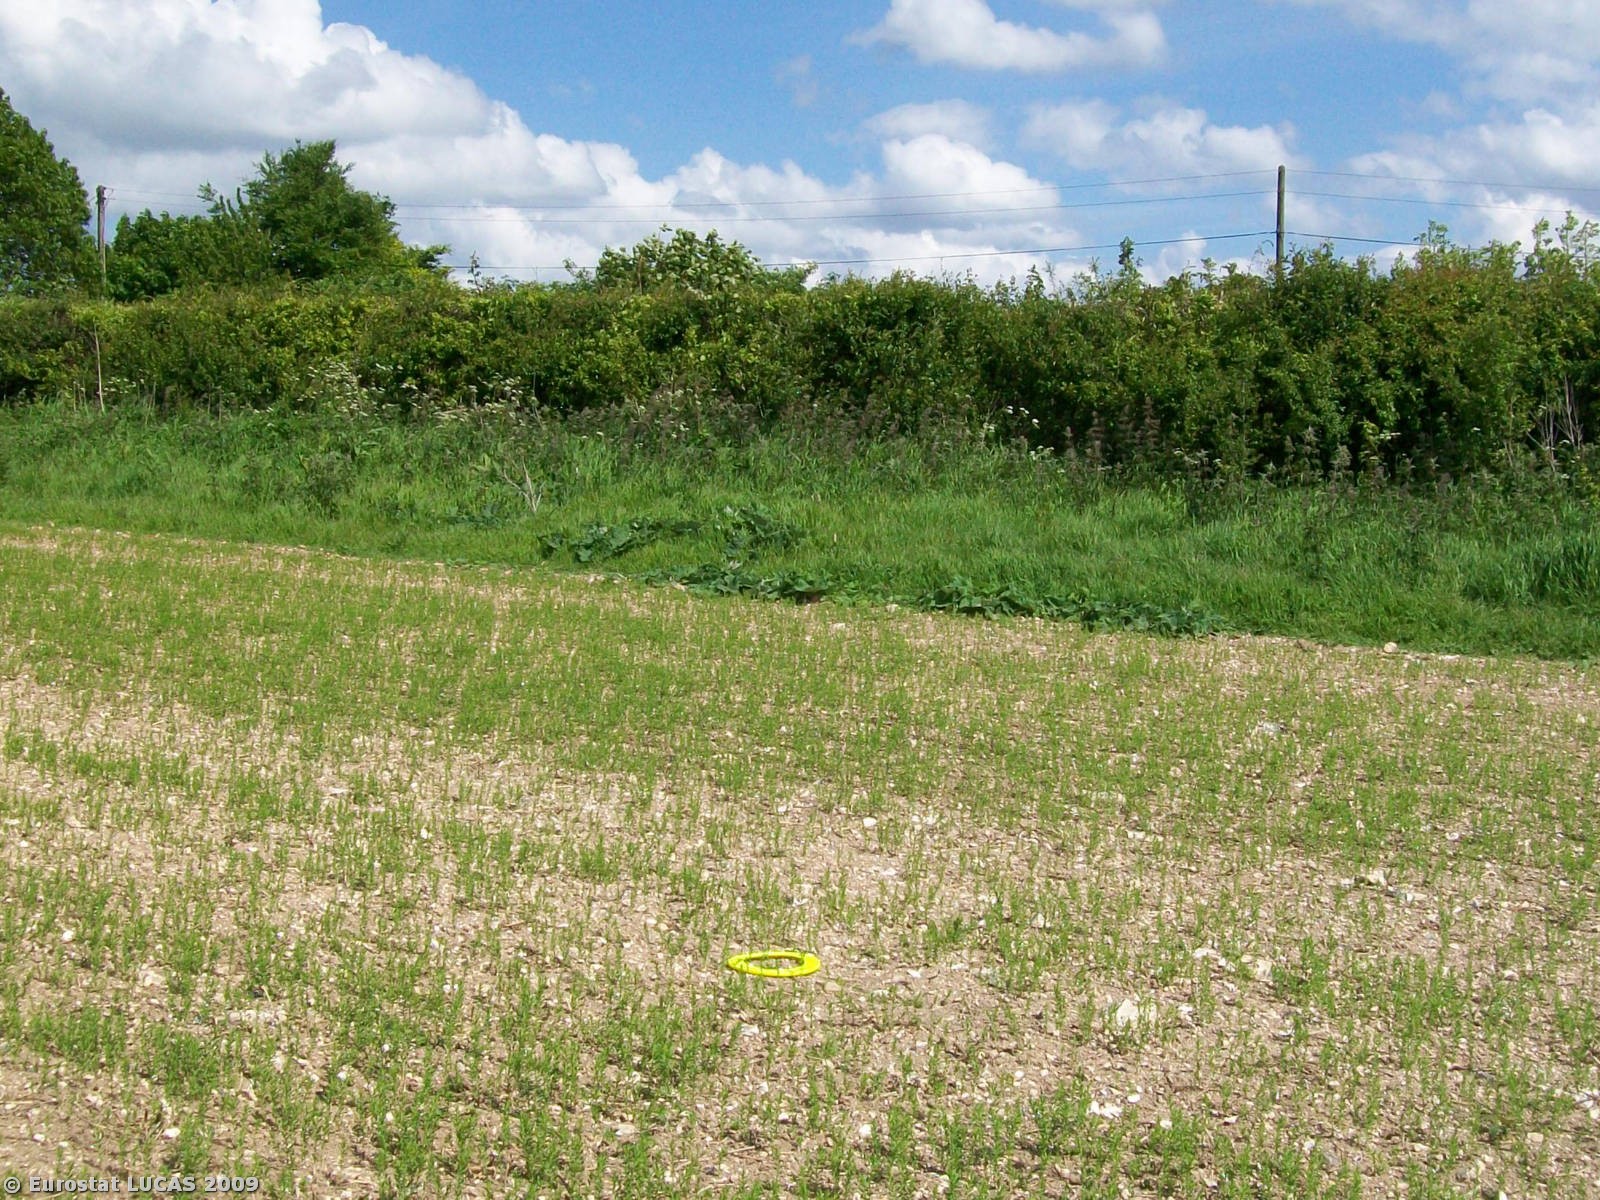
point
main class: Cropland
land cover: Other fibre and oleaginous crops
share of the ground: 50 - 75 %
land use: Agriculture (excluding fallow land and kitchen gardens)
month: May
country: GB
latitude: 50.9183
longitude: -2.1082
